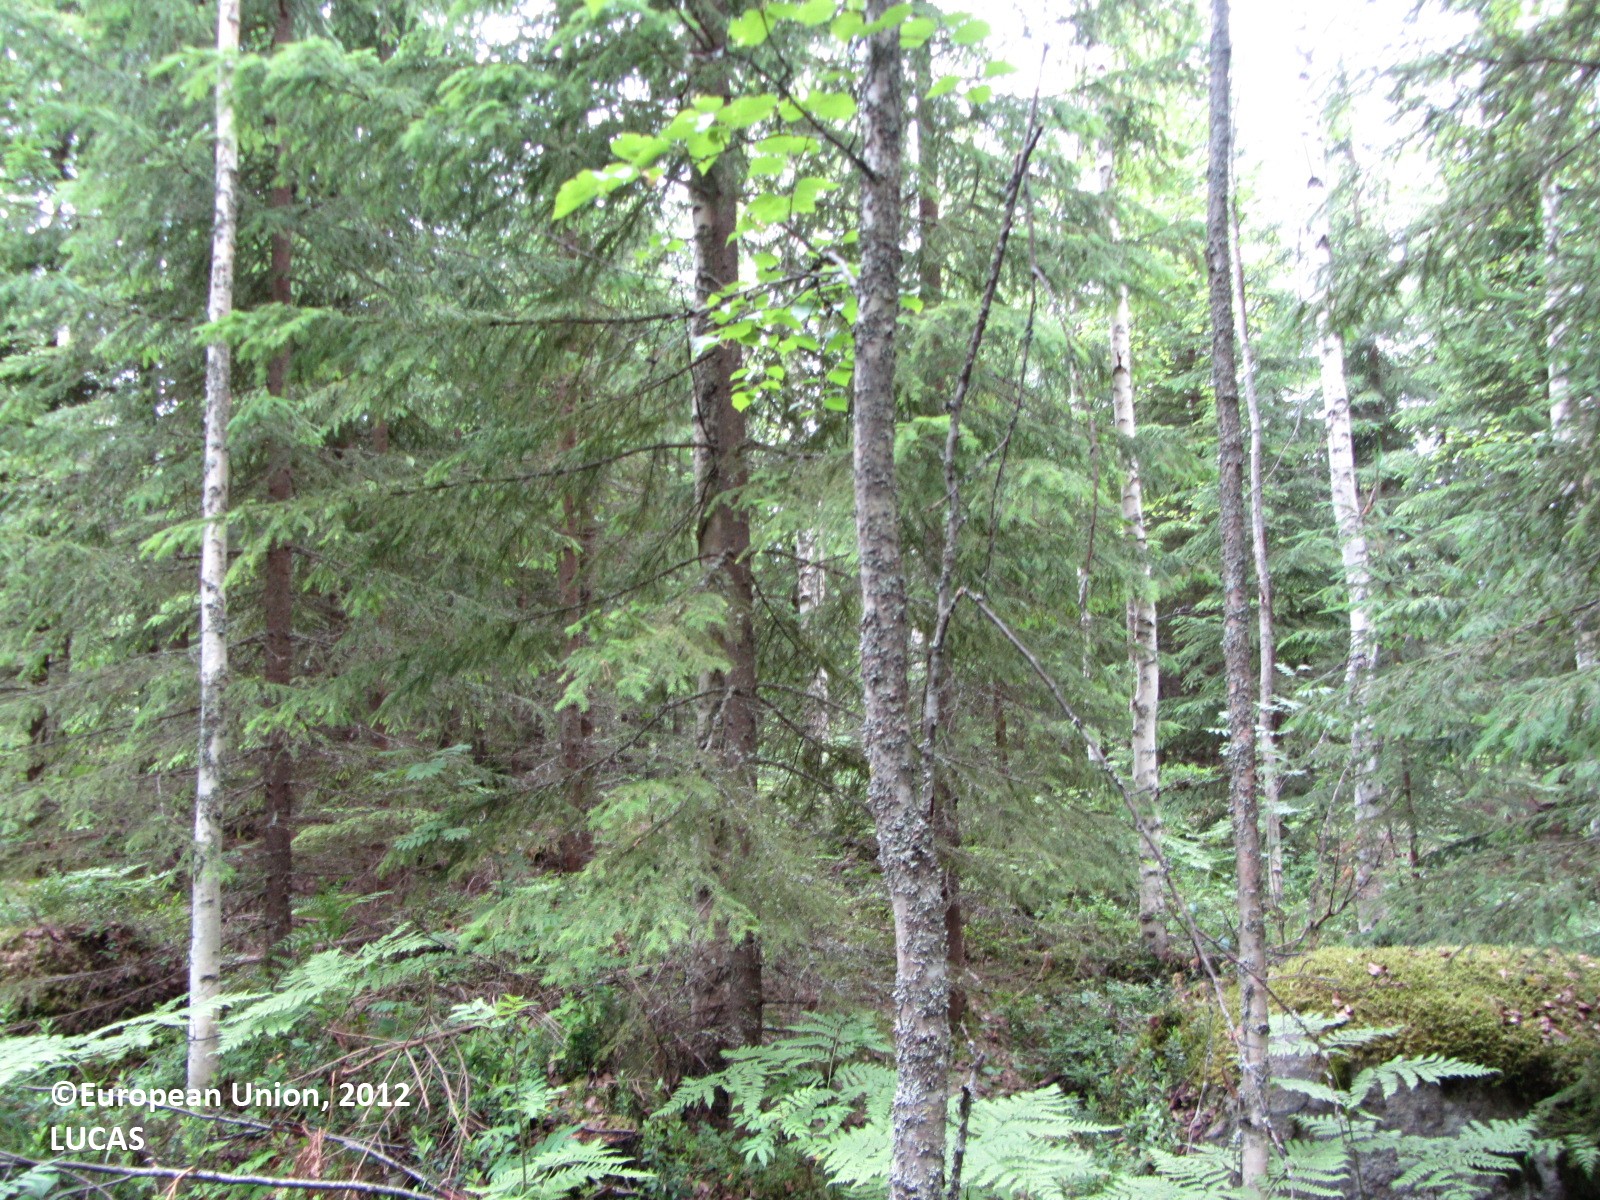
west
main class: Woodland
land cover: Spruce dominated mixed woodland
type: boreal forest
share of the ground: > 75 %
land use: Forestry
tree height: > 5 m
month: June
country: FI
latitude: 62.6465
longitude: 25.5424
